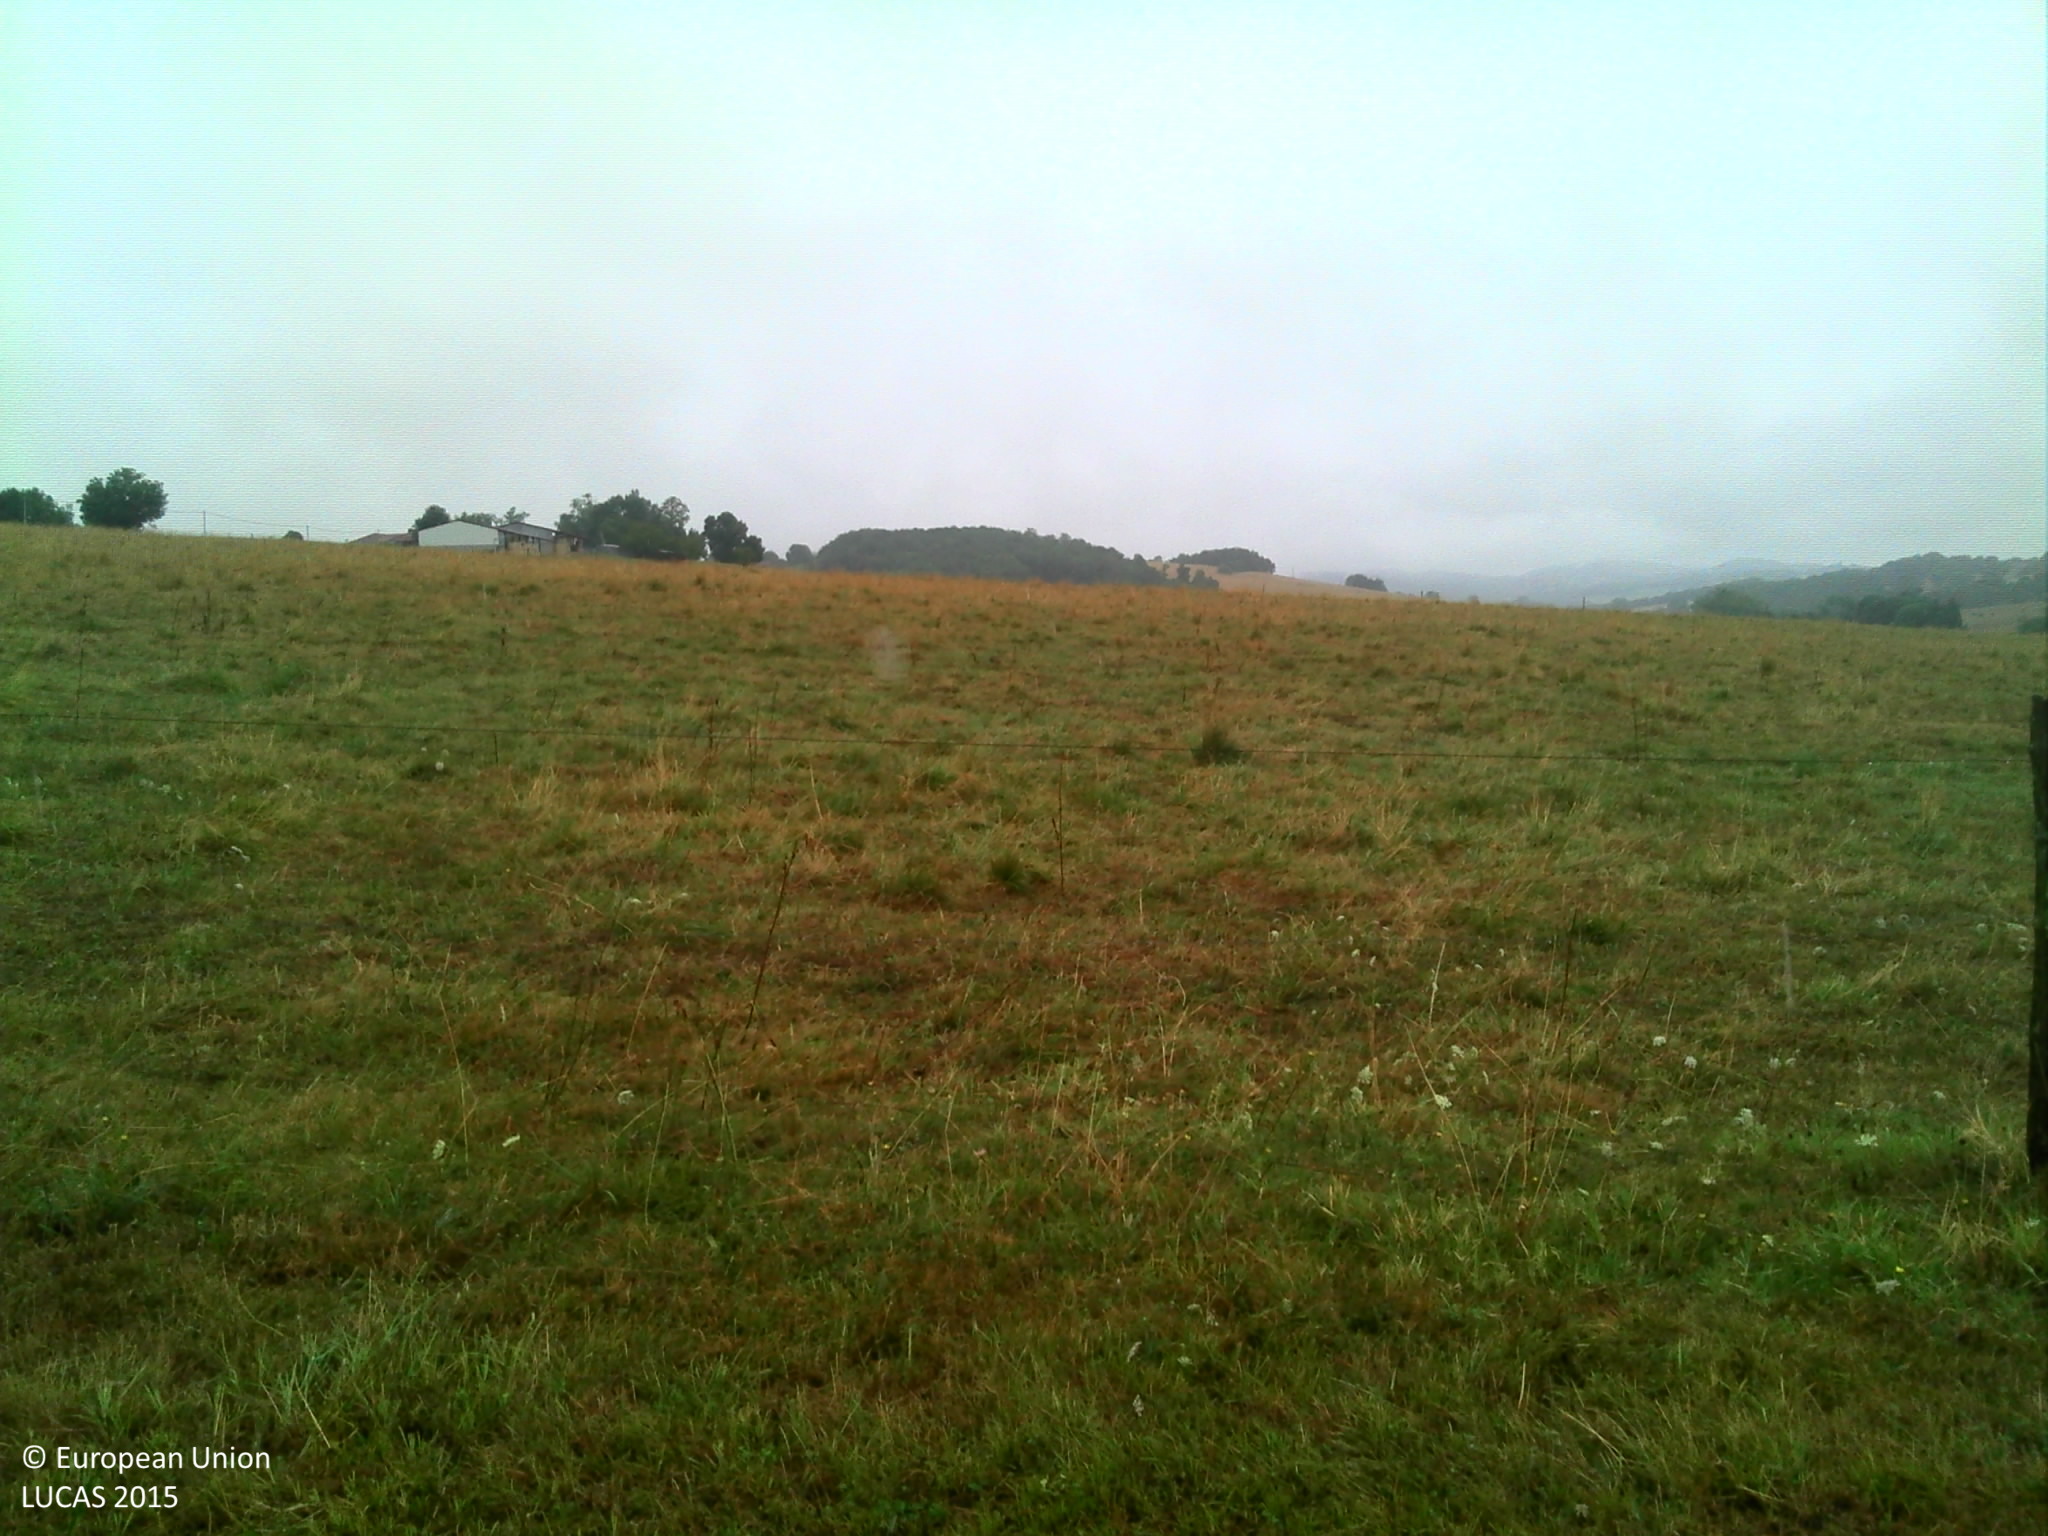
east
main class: Grassland
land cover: Grassland without tree/shrub cover
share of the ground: > 75 %
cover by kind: herbaceous plants 100 %
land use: Agriculture (excluding fallow land and kitchen gardens)
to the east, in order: Grassland without tree/shrub cover; Fences; Grassland without tree/shrub cover; Fences; Grassland without tree/shrub cover
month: July
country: FR
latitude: 43.2336
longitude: 0.8033
